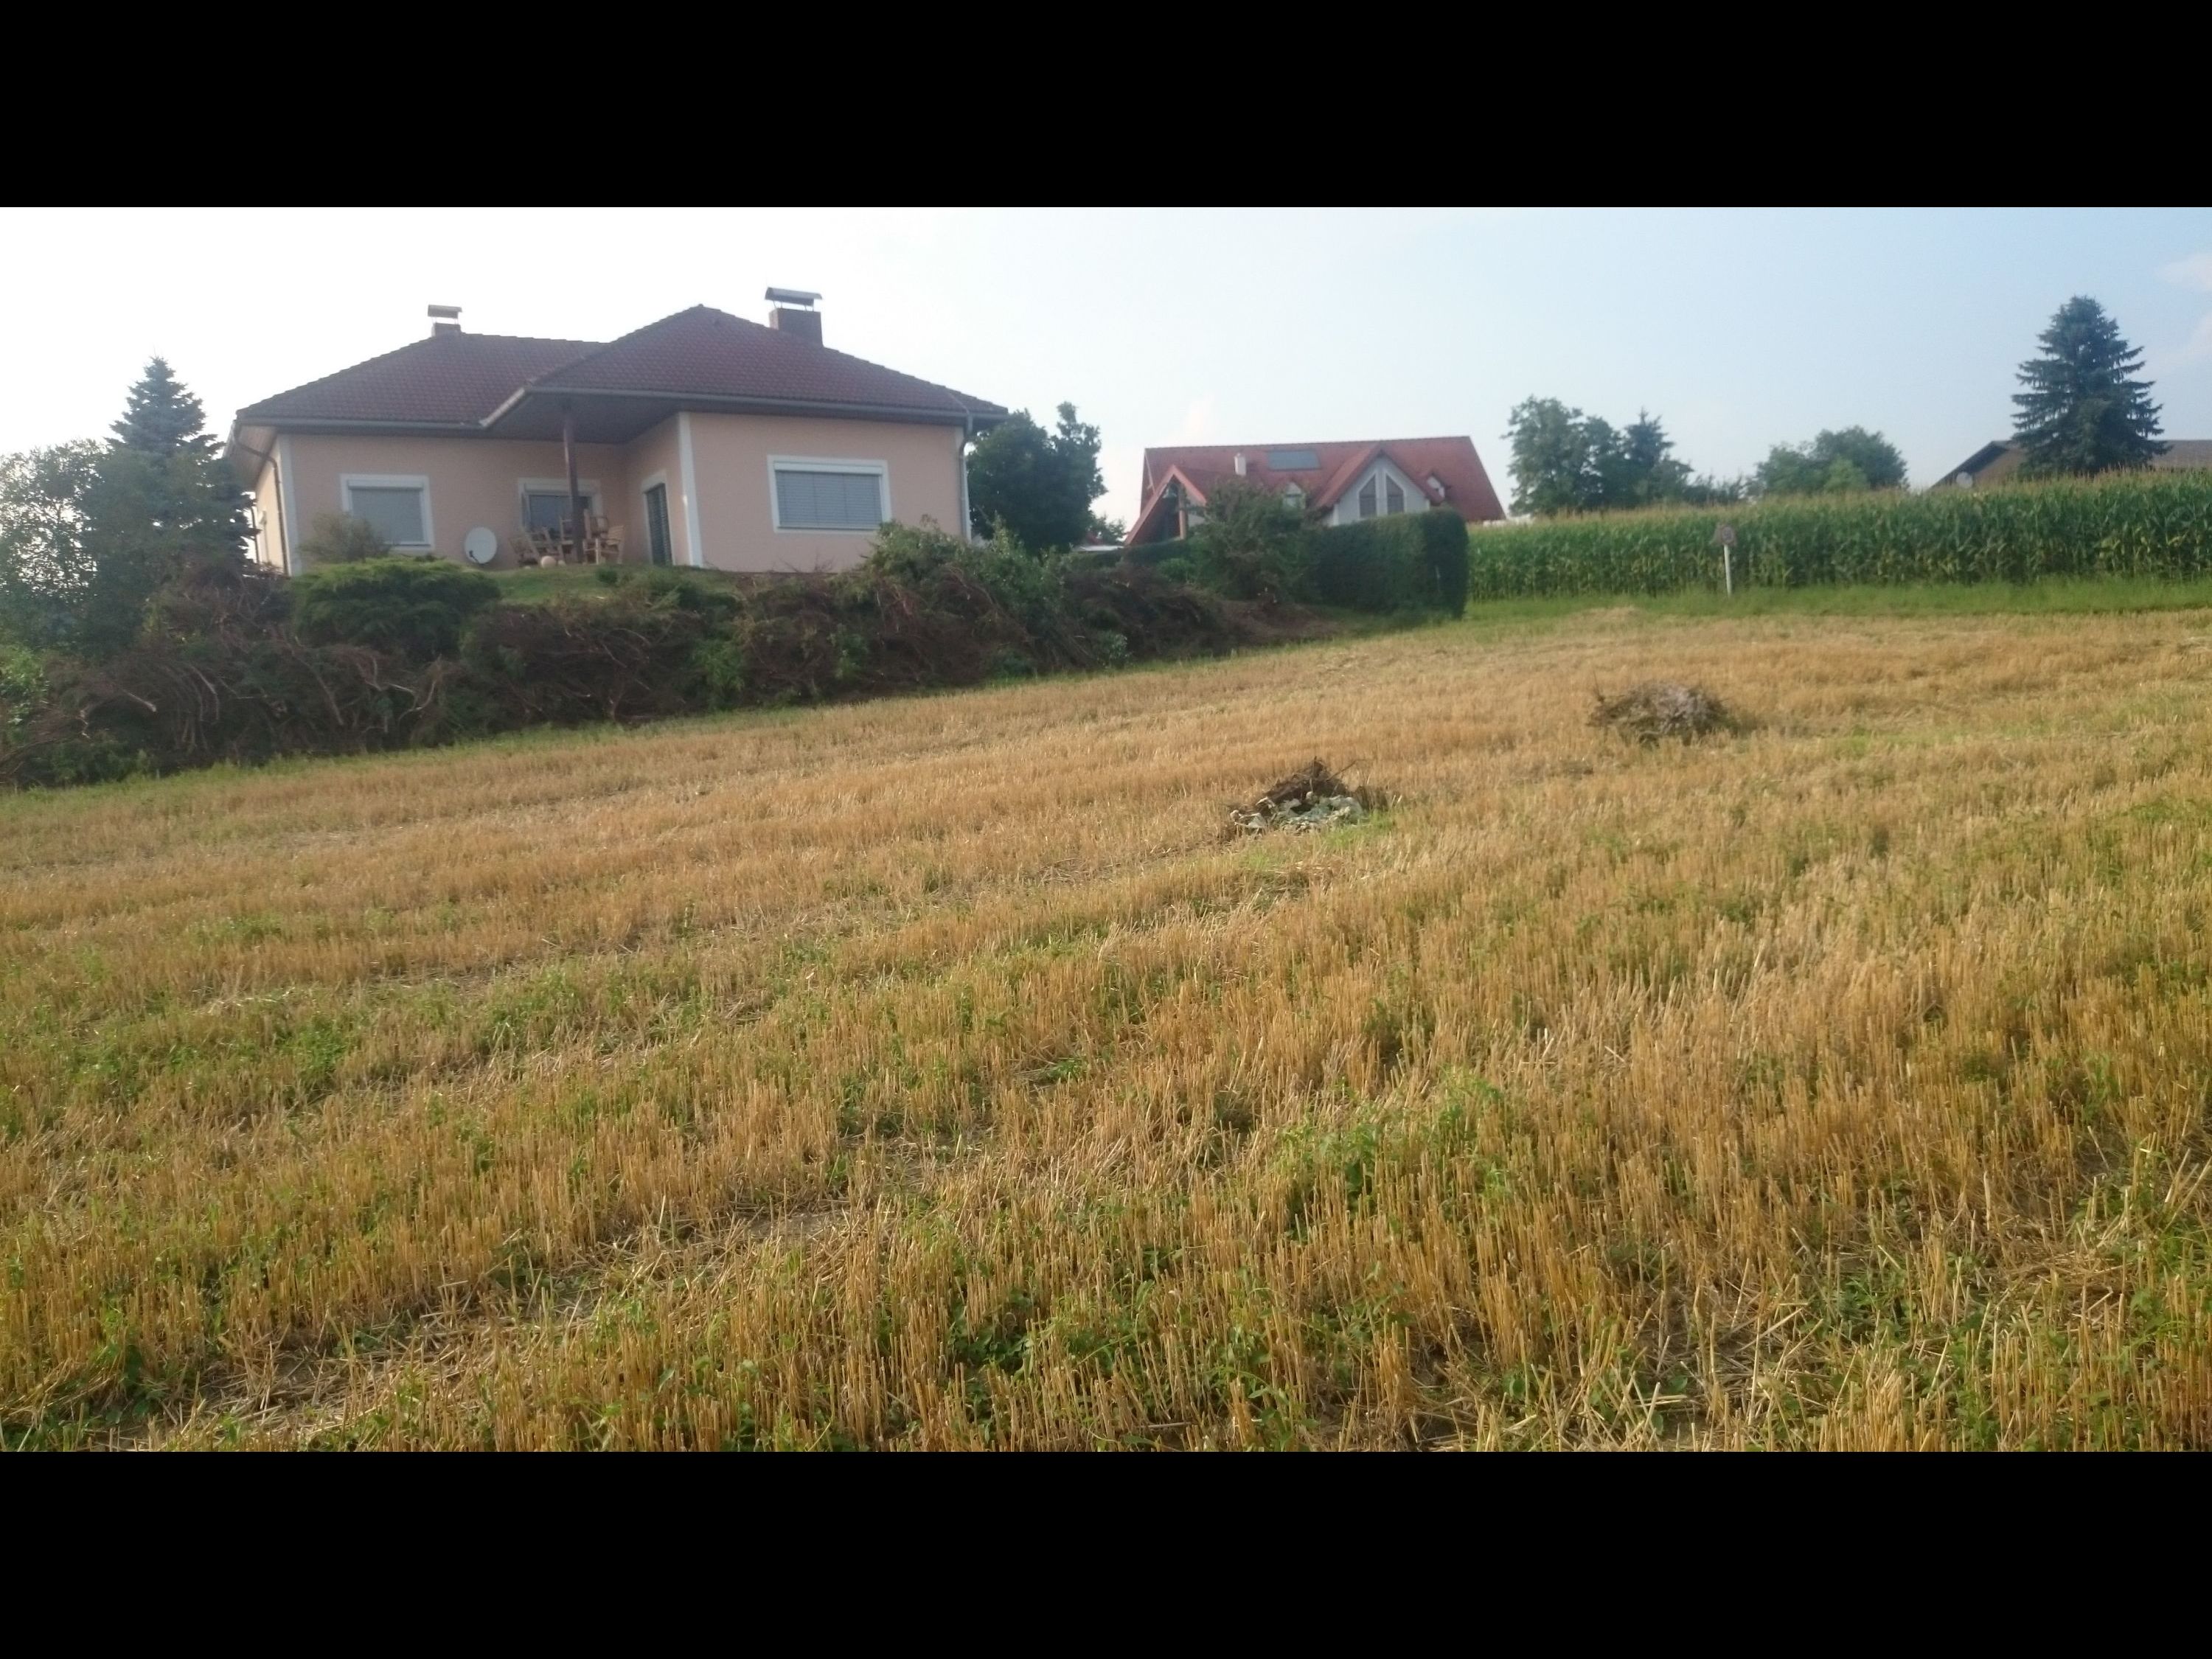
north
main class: Cropland
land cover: Common wheat
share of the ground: > 75 %
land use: Agriculture (excluding fallow land and kitchen gardens)
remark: Harvested field
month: July
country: AT
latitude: 47.0543
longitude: 15.9117
